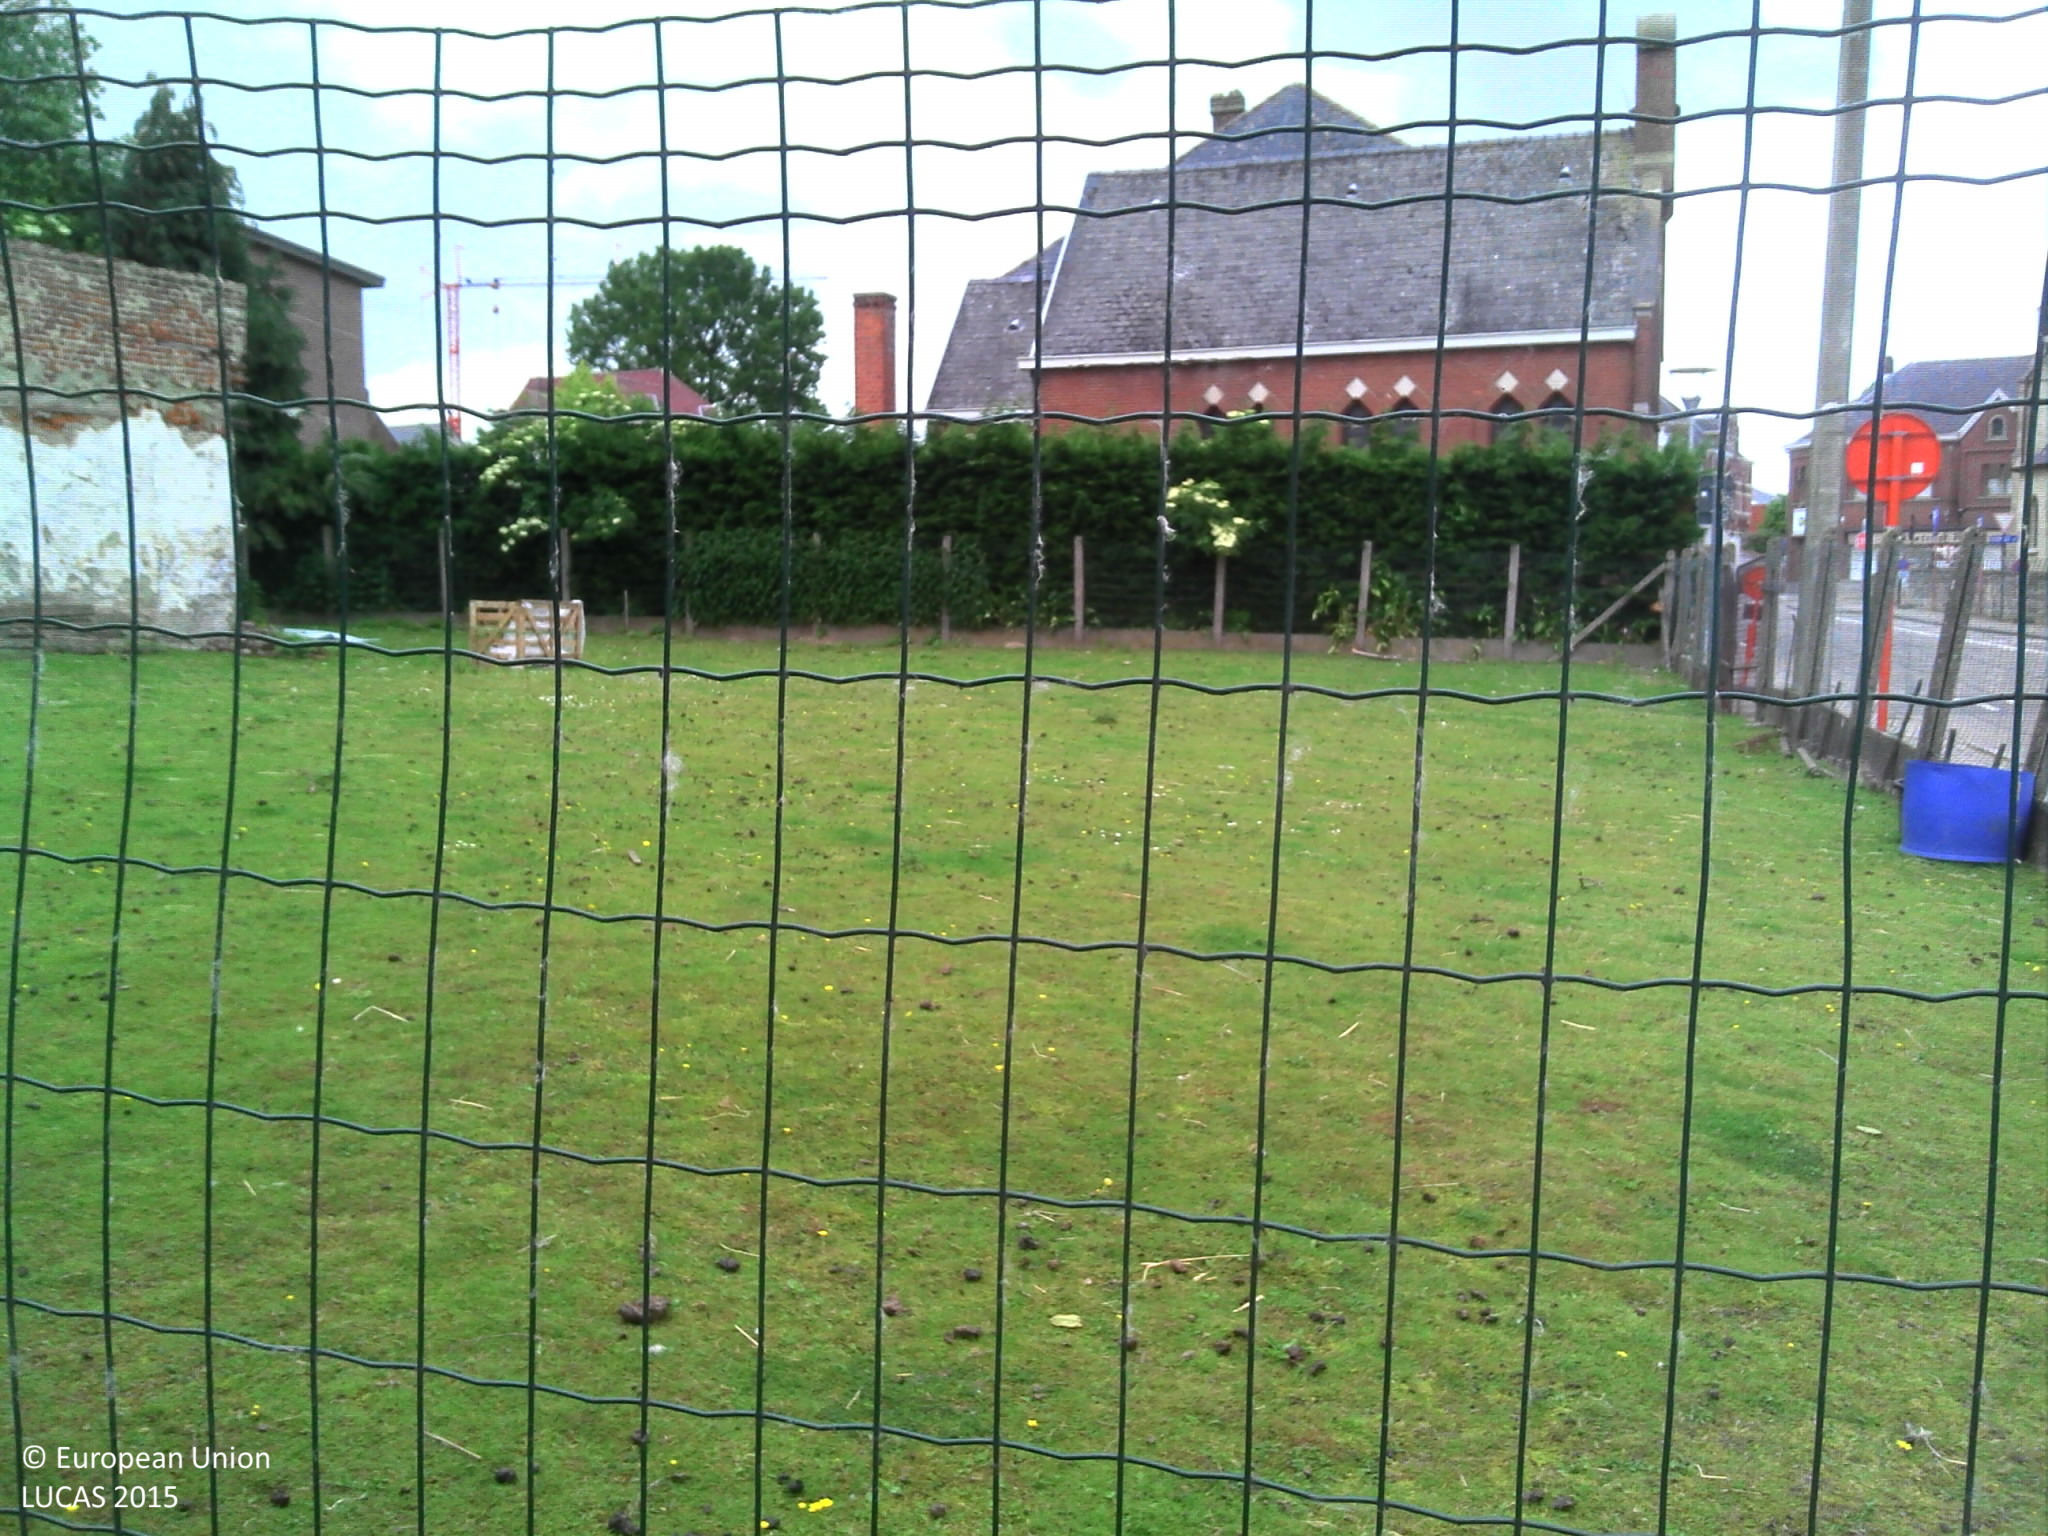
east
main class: Grassland
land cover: Grassland with sparse tree/shrub cover
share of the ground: > 75 %
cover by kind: herbaceous plants 95 %, broadleaved forest trees 5 %
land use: Residential
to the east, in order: Grassland with sparse tree/shrub cover; Fences; Grassland with sparse tree/shrub cover; Artificial constructions in urban areas; Grassland without tree/shrub cover
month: June
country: BE
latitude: 50.9042
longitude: 3.8932
